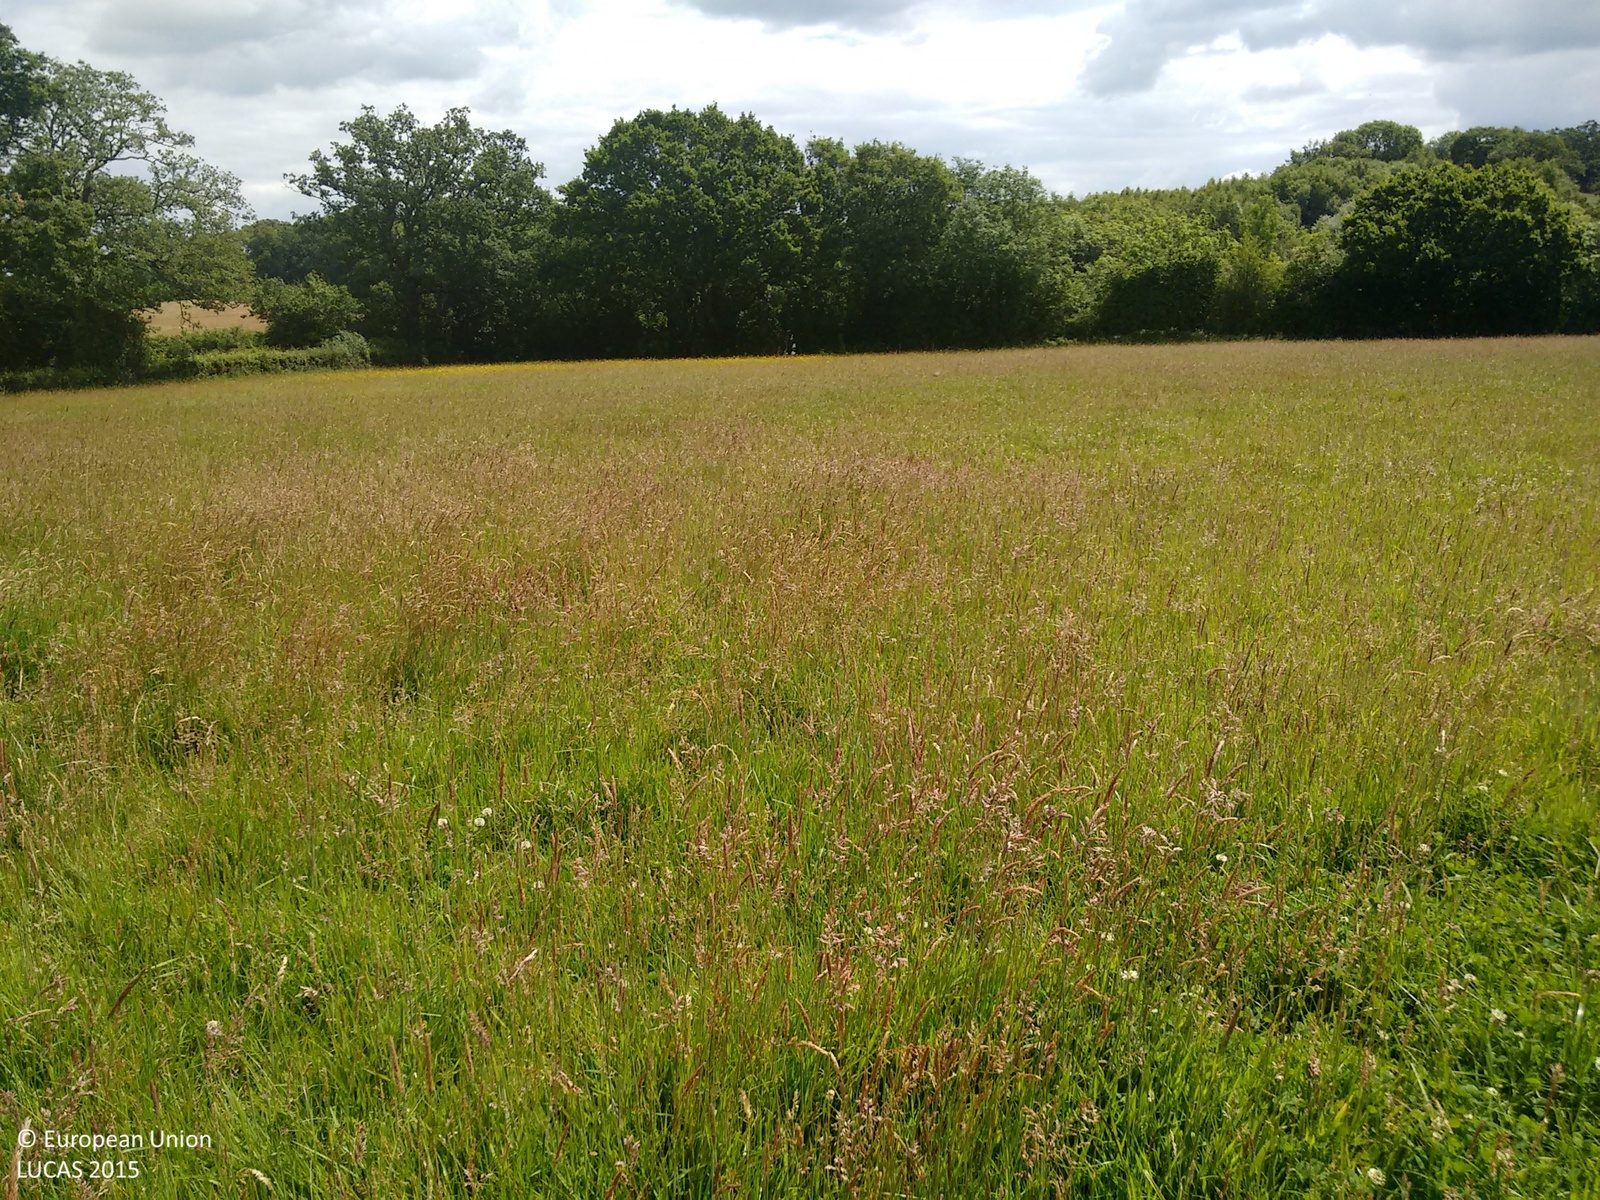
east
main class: Grassland
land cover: Grassland without tree/shrub cover
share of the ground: > 75 %
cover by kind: herbaceous plants 100 %
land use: Agriculture (excluding fallow land and kitchen gardens)
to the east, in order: Grassland without tree/shrub cover; Fences; Broadleaved woodland; Artificial constructions in urban areas; Broadleaved woodland; Tracks; Broadleaved woodland; Tracks
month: June
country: GB
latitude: 50.7797
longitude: -2.0430
